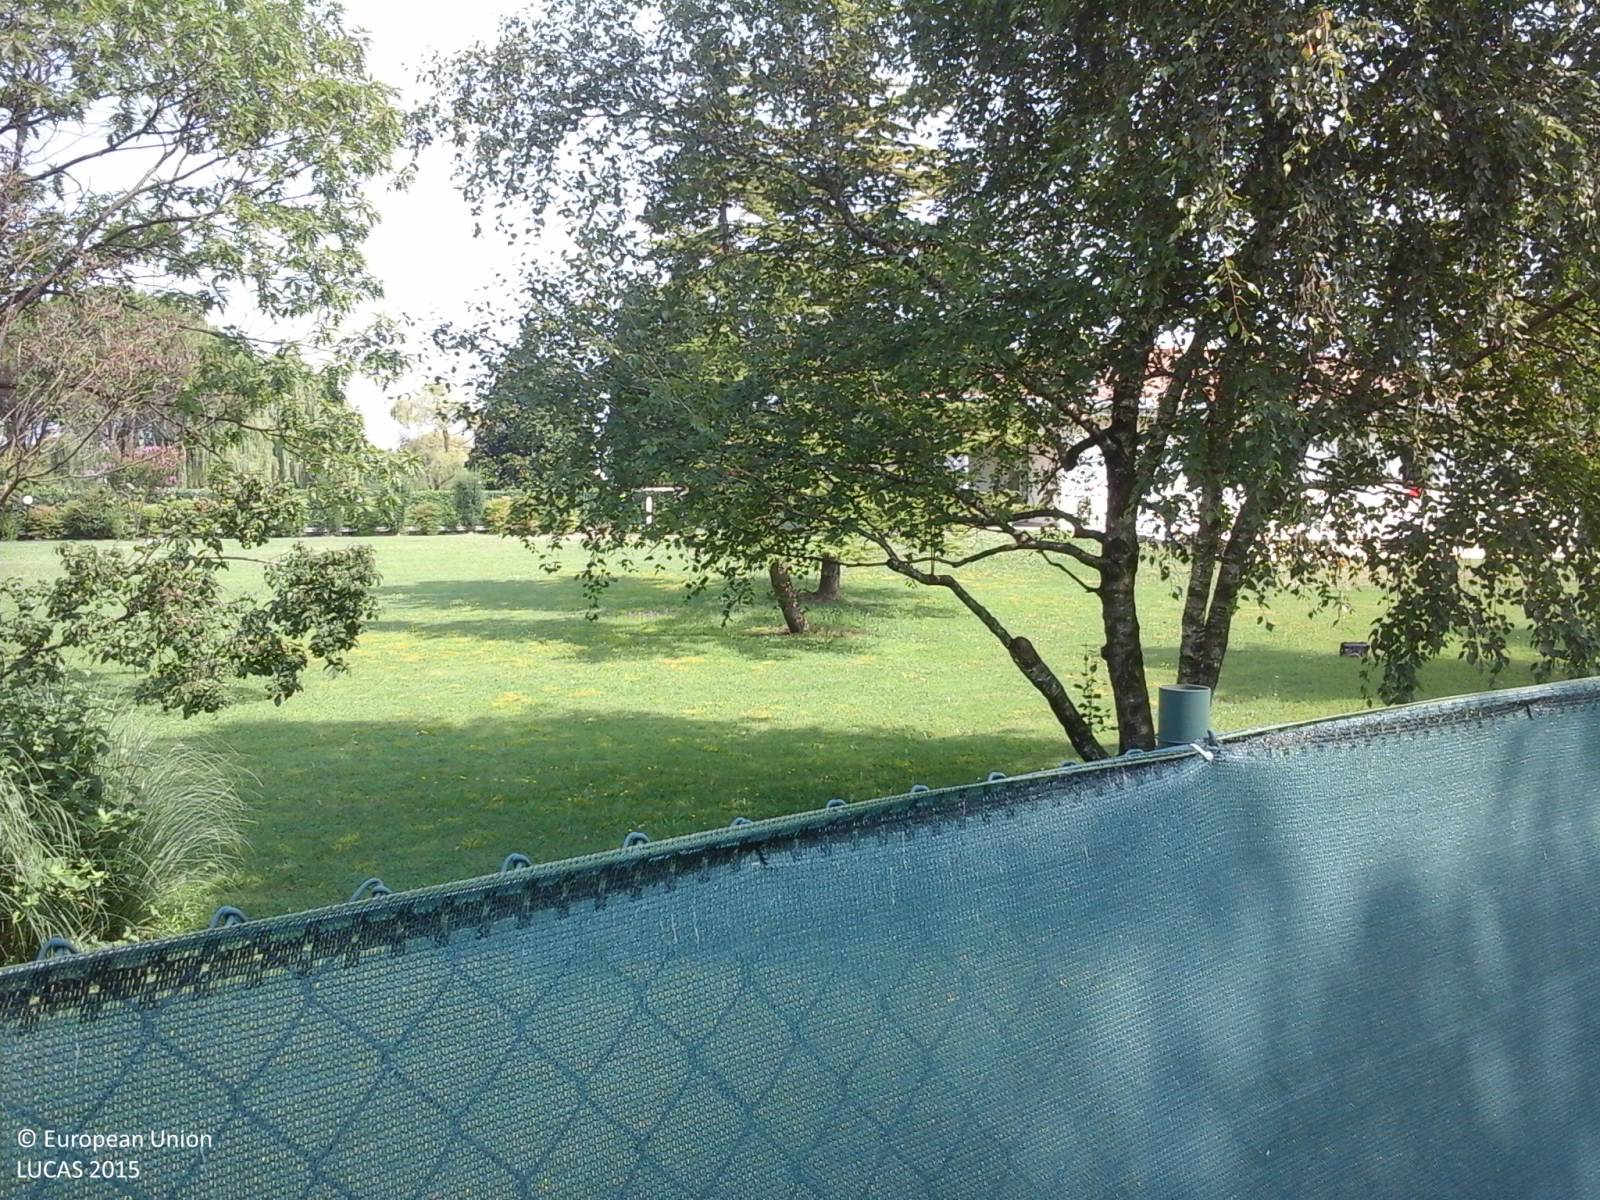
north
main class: Grassland
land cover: Grassland with sparse tree/shrub cover
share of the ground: > 75 %
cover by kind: herbaceous plants 85 %, shrubs 10 %, coniferous forest trees 5 %
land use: Residential
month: July
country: IT
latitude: 45.9568
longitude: 12.6932
